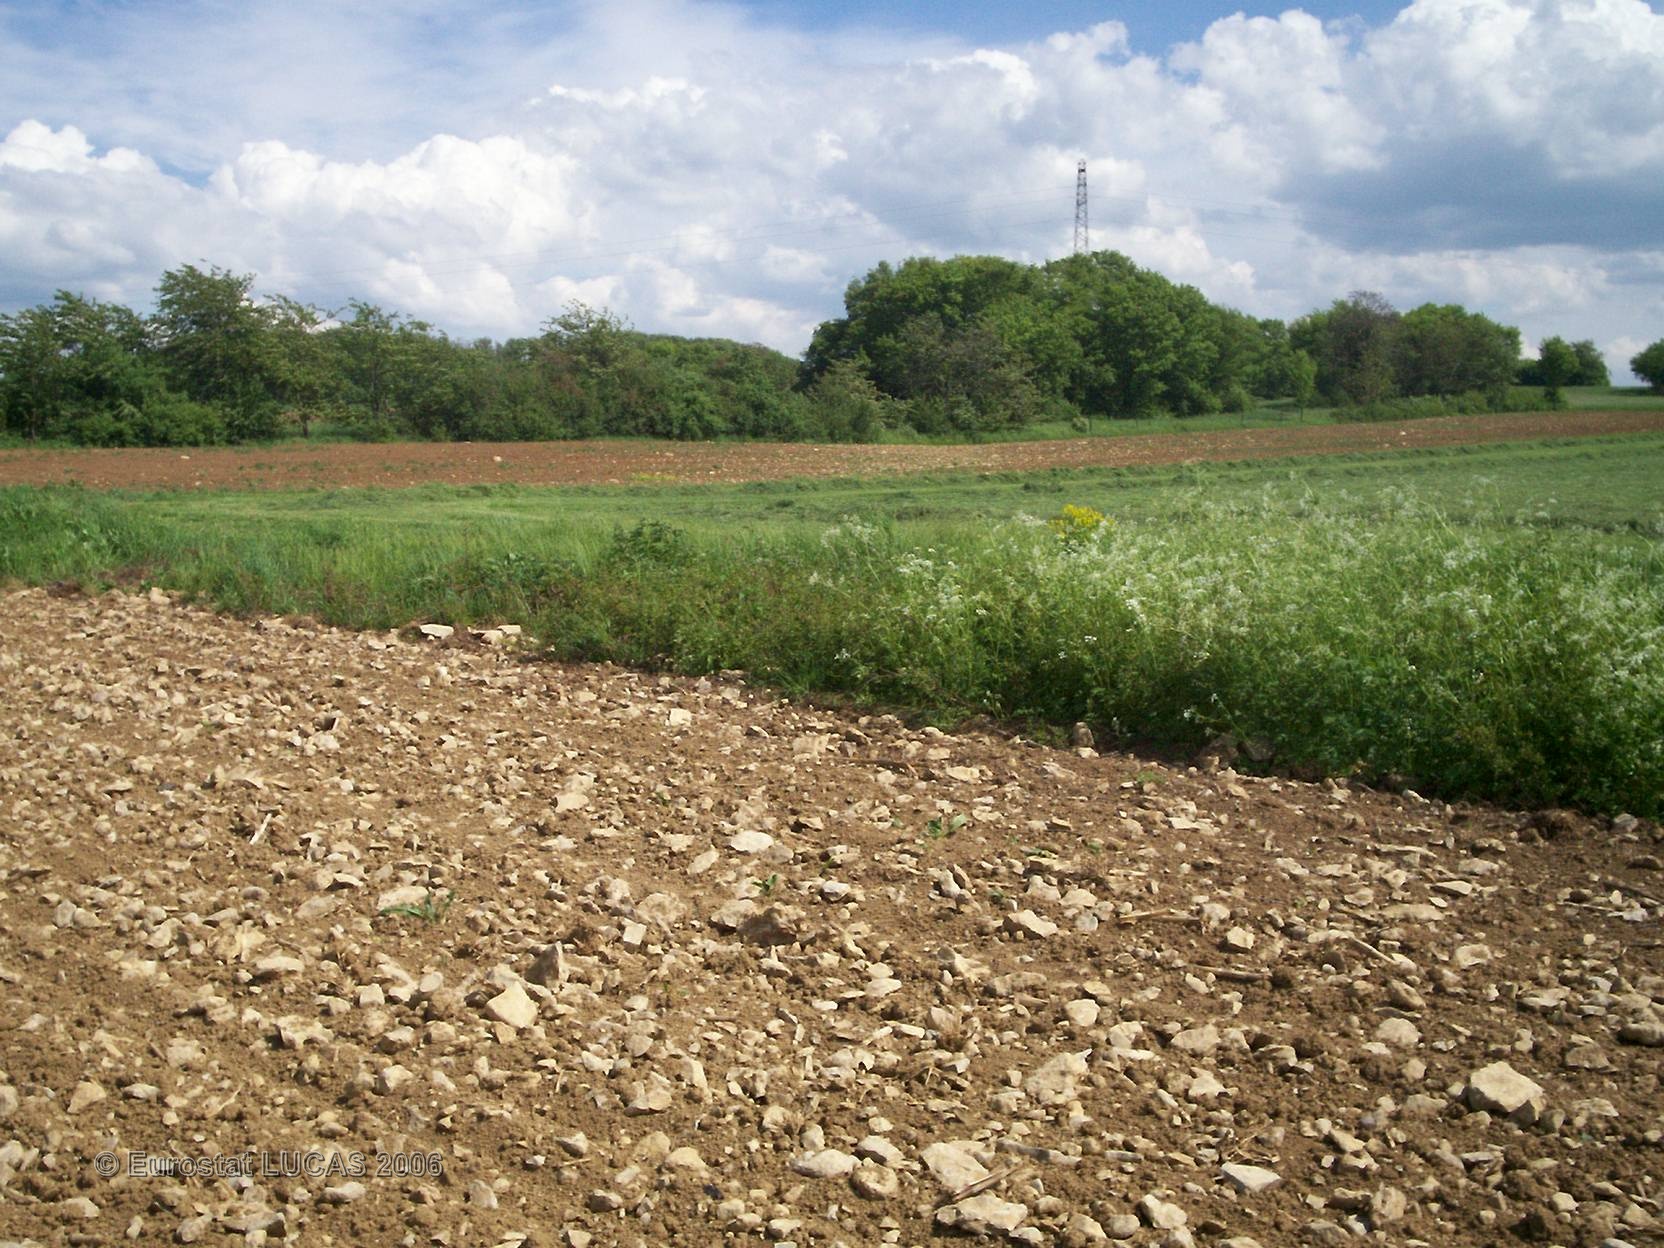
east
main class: Cropland
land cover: Maize
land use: Agriculture (excluding fallow land and kitchen gardens)
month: May
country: FR
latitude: 48.7789
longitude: 7.0747
